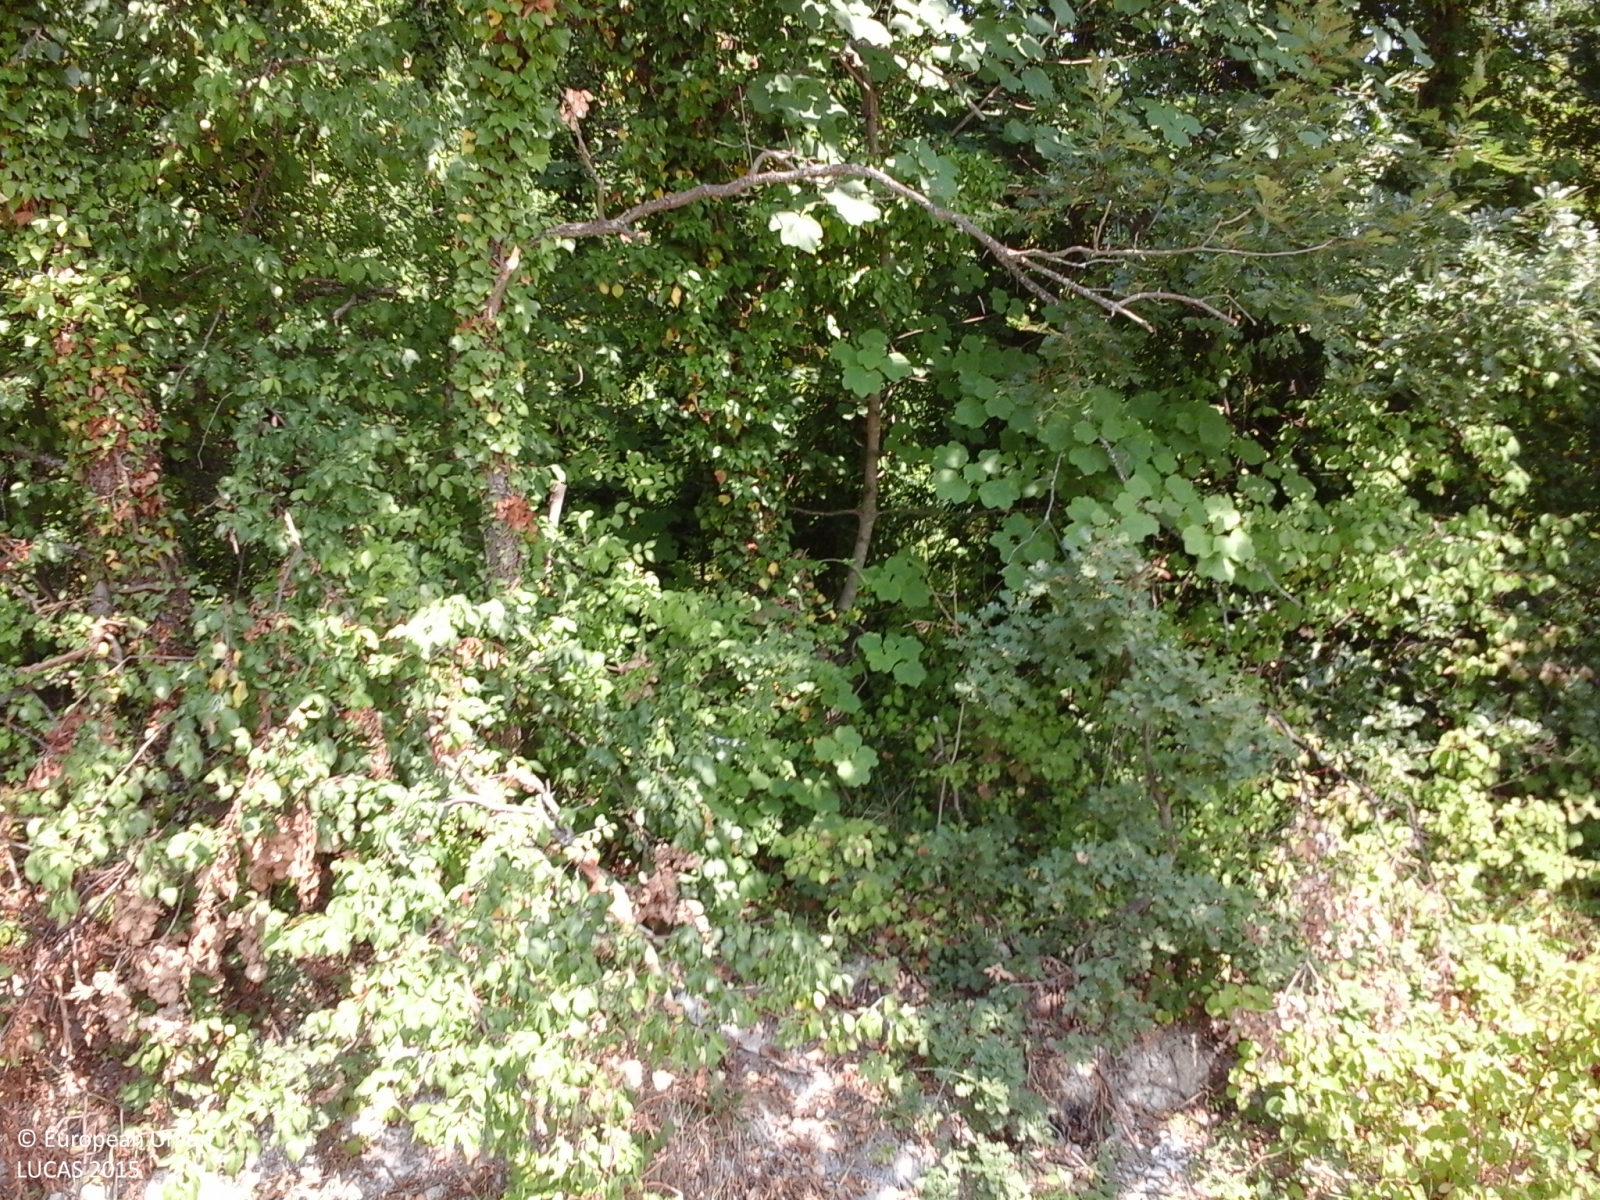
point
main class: Woodland
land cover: Broadleaved woodland
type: thermophilous deciduous forest
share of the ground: > 75 %
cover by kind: broadleaved forest trees 85 %, shrubs 10 %, herbaceous plants 5 %
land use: Semi-natural and natural areas not in use
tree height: > 5 m
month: August
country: IT
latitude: 41.9095
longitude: 14.7469
